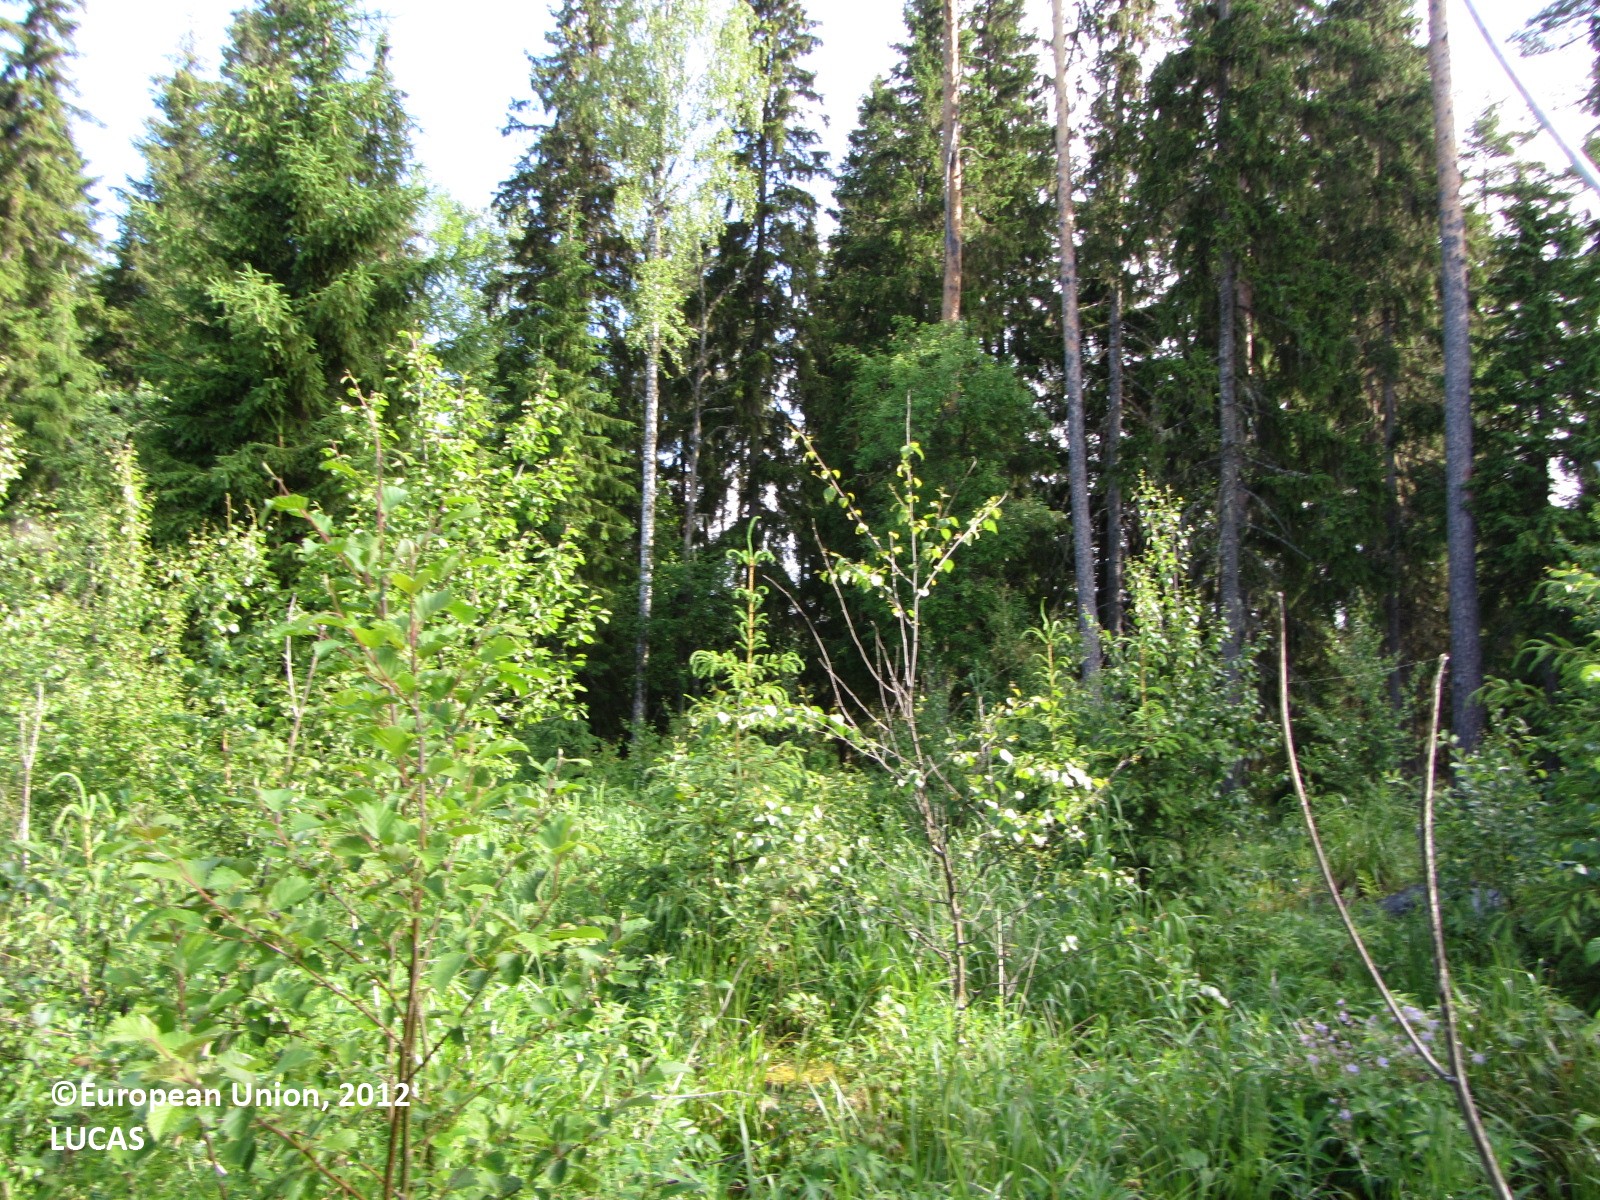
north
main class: Woodland
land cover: Broadleaved woodland
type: boreal forest
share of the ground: > 75 %
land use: Forestry
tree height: > 5 m
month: July
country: FI
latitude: 62.9560
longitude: 25.5847
